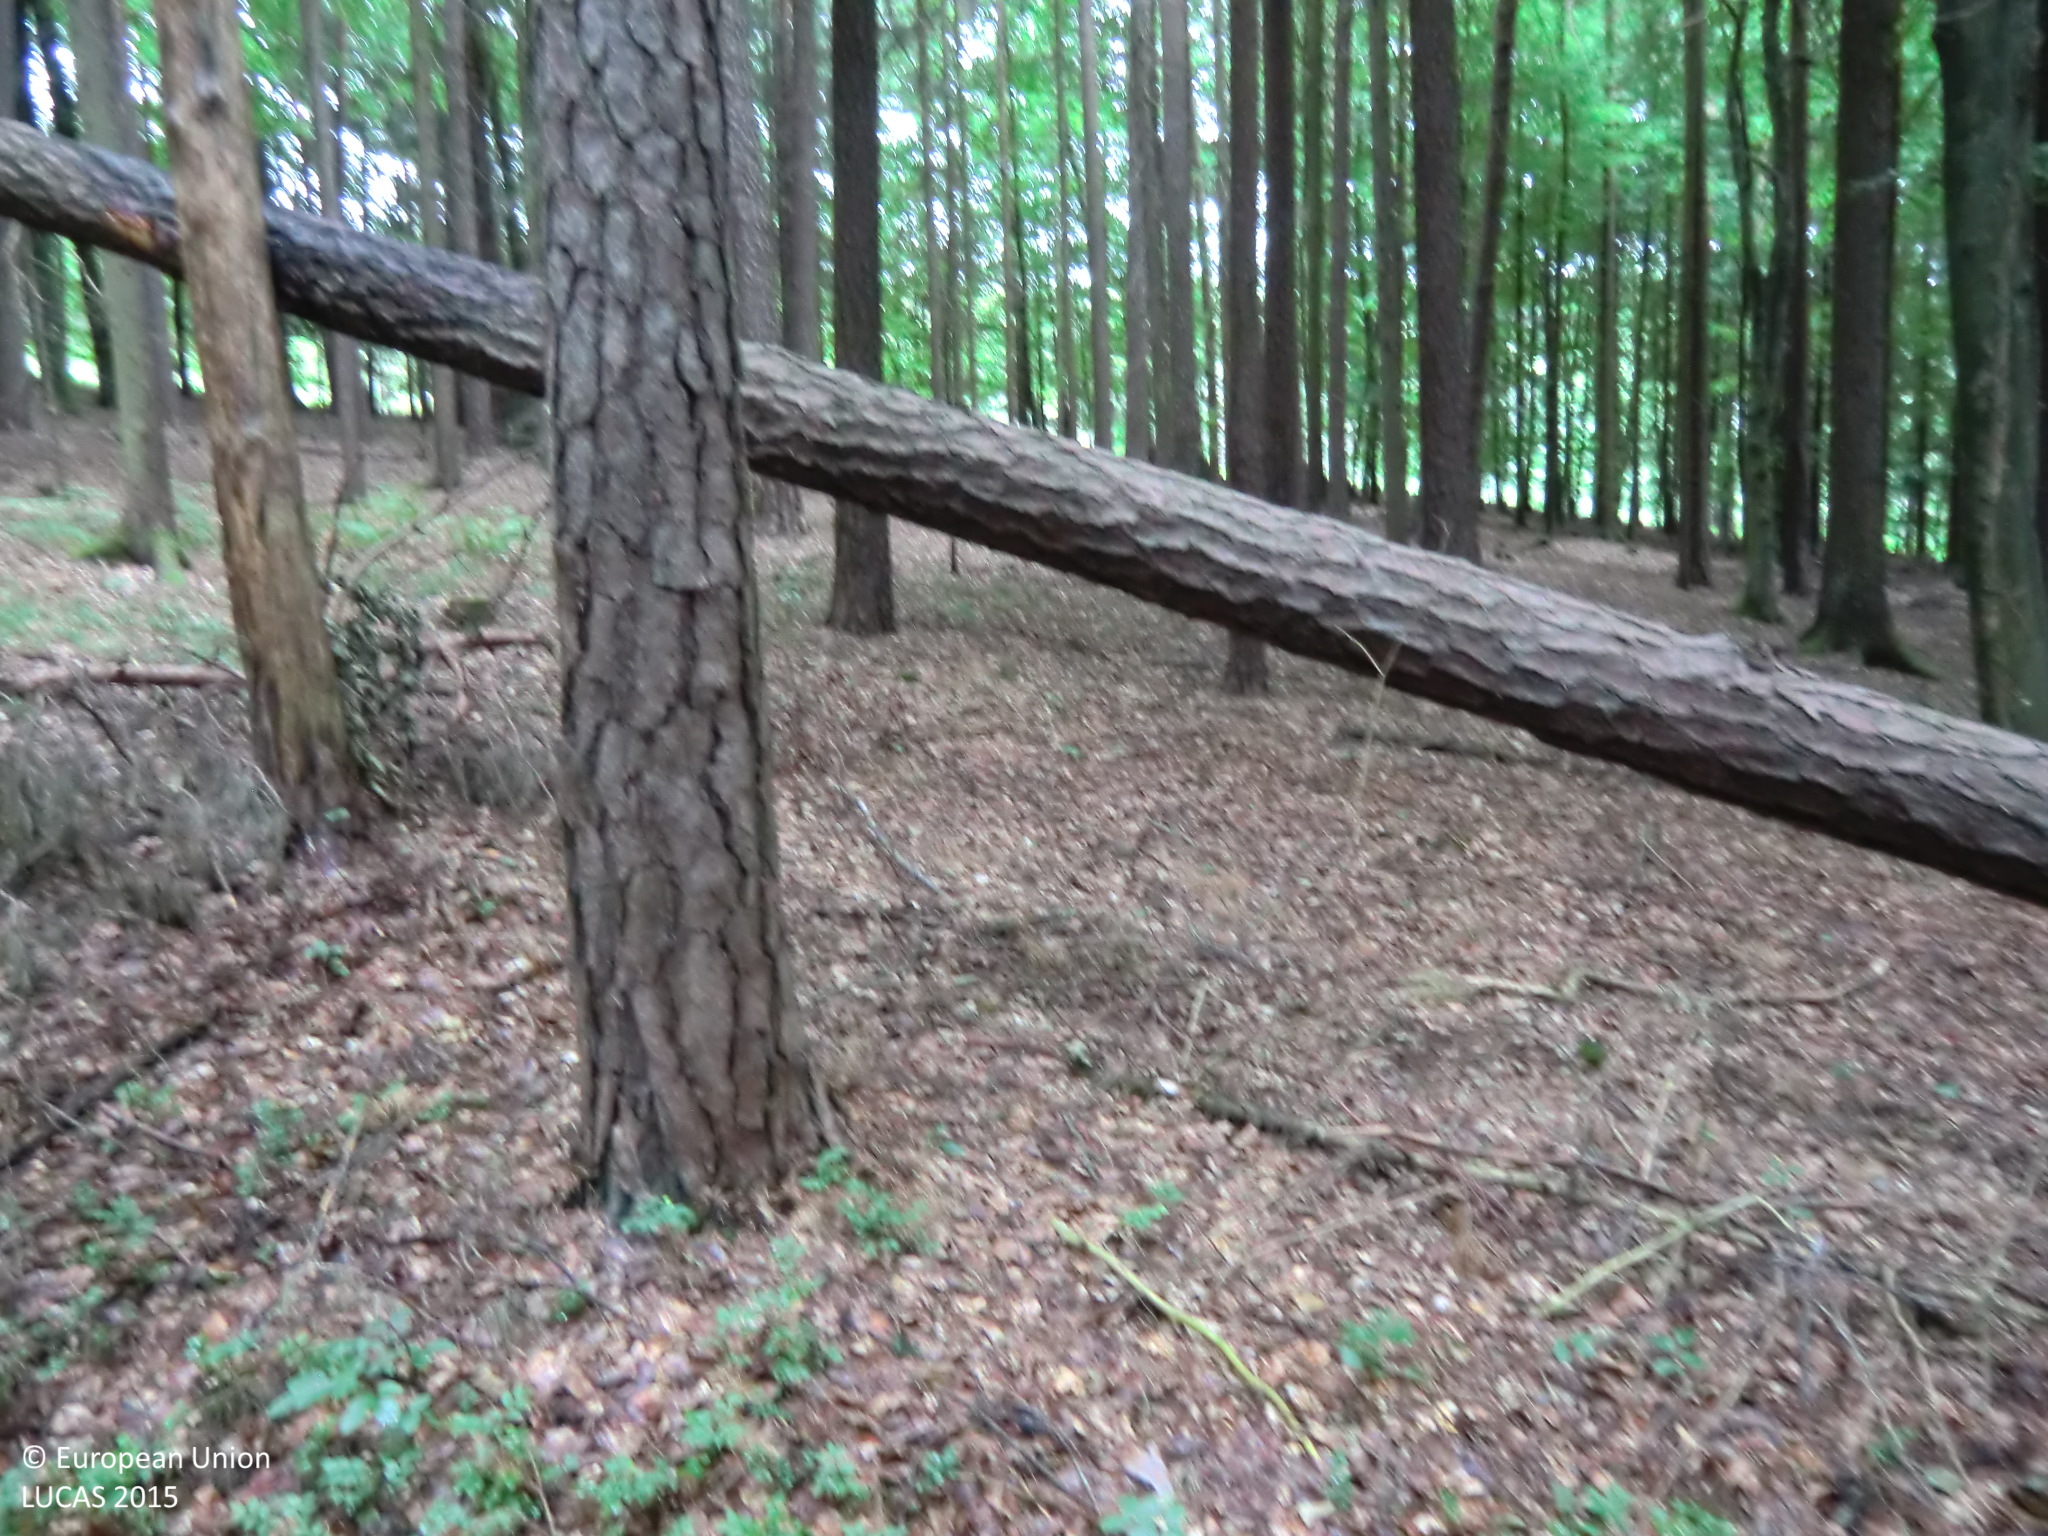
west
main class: Woodland
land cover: Pine dominated mixed woodland
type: hemiboreal forest and nemoral coniferous forest and mixed broadleaved-coniferous forest
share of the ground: > 75 %
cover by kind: coniferous forest trees 40 %, broadleaved forest trees 40 %, shrubs 10 %, unconsolidated bare surface 10 %
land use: Forestry
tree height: > 5 m
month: June
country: AT
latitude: 47.1576
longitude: 16.0028
